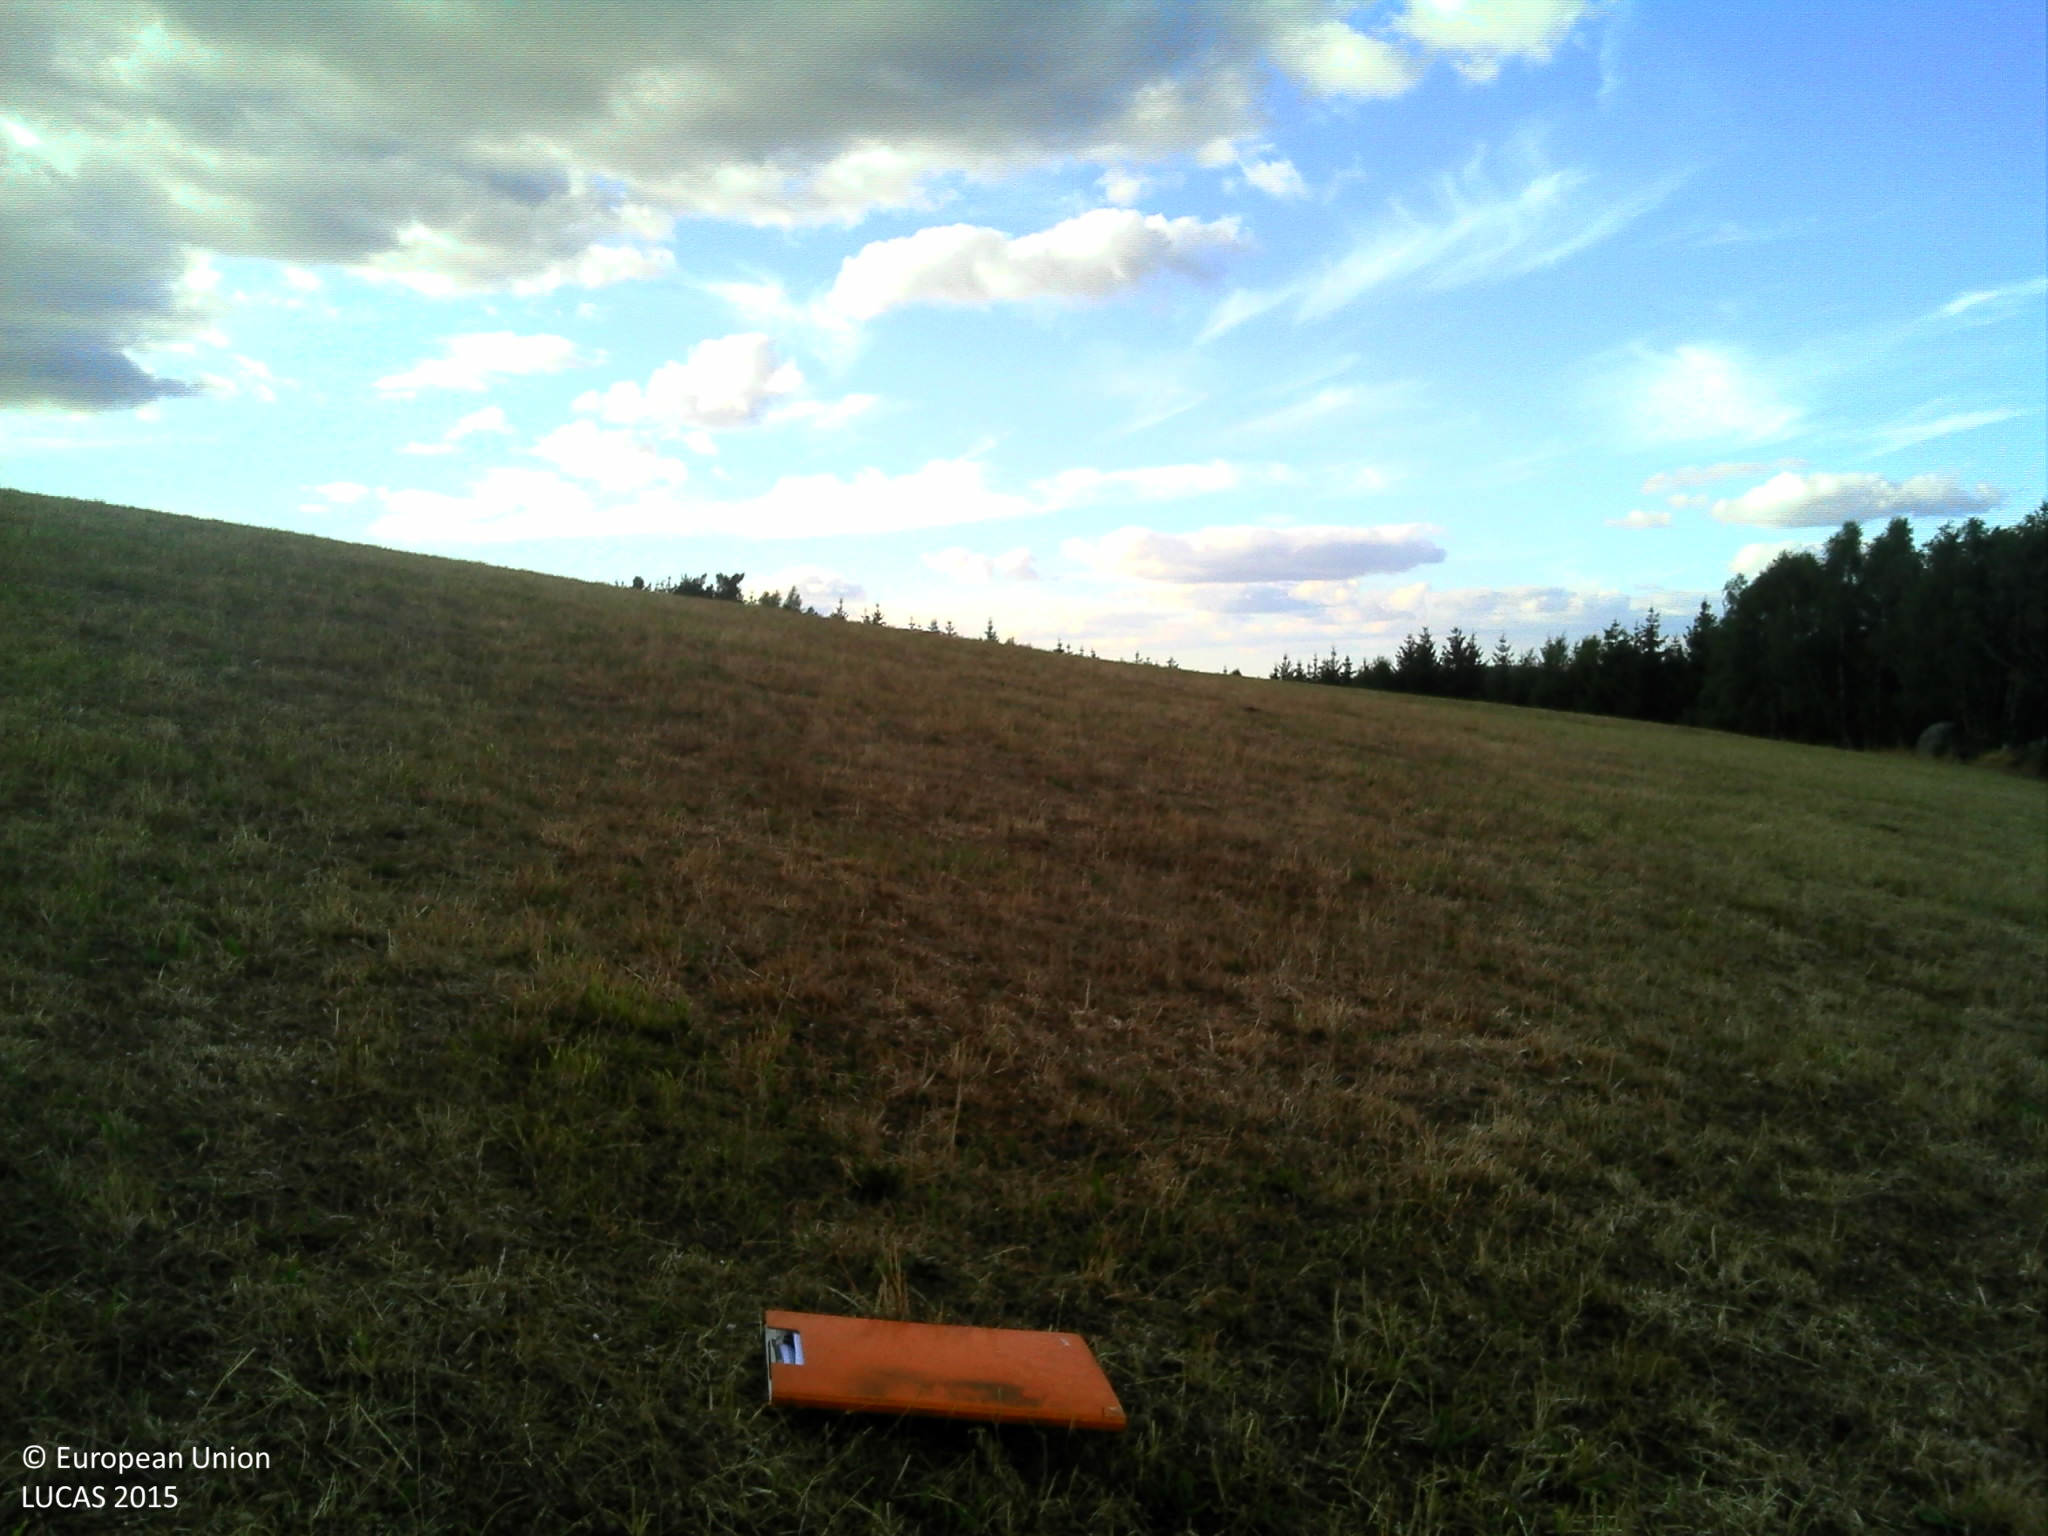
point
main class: Grassland
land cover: Grassland without tree/shrub cover
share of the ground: > 75 %
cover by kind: herbaceous plants 100 %
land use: Agriculture (excluding fallow land and kitchen gardens)
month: July
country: FR
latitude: 44.7456
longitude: 3.2467
